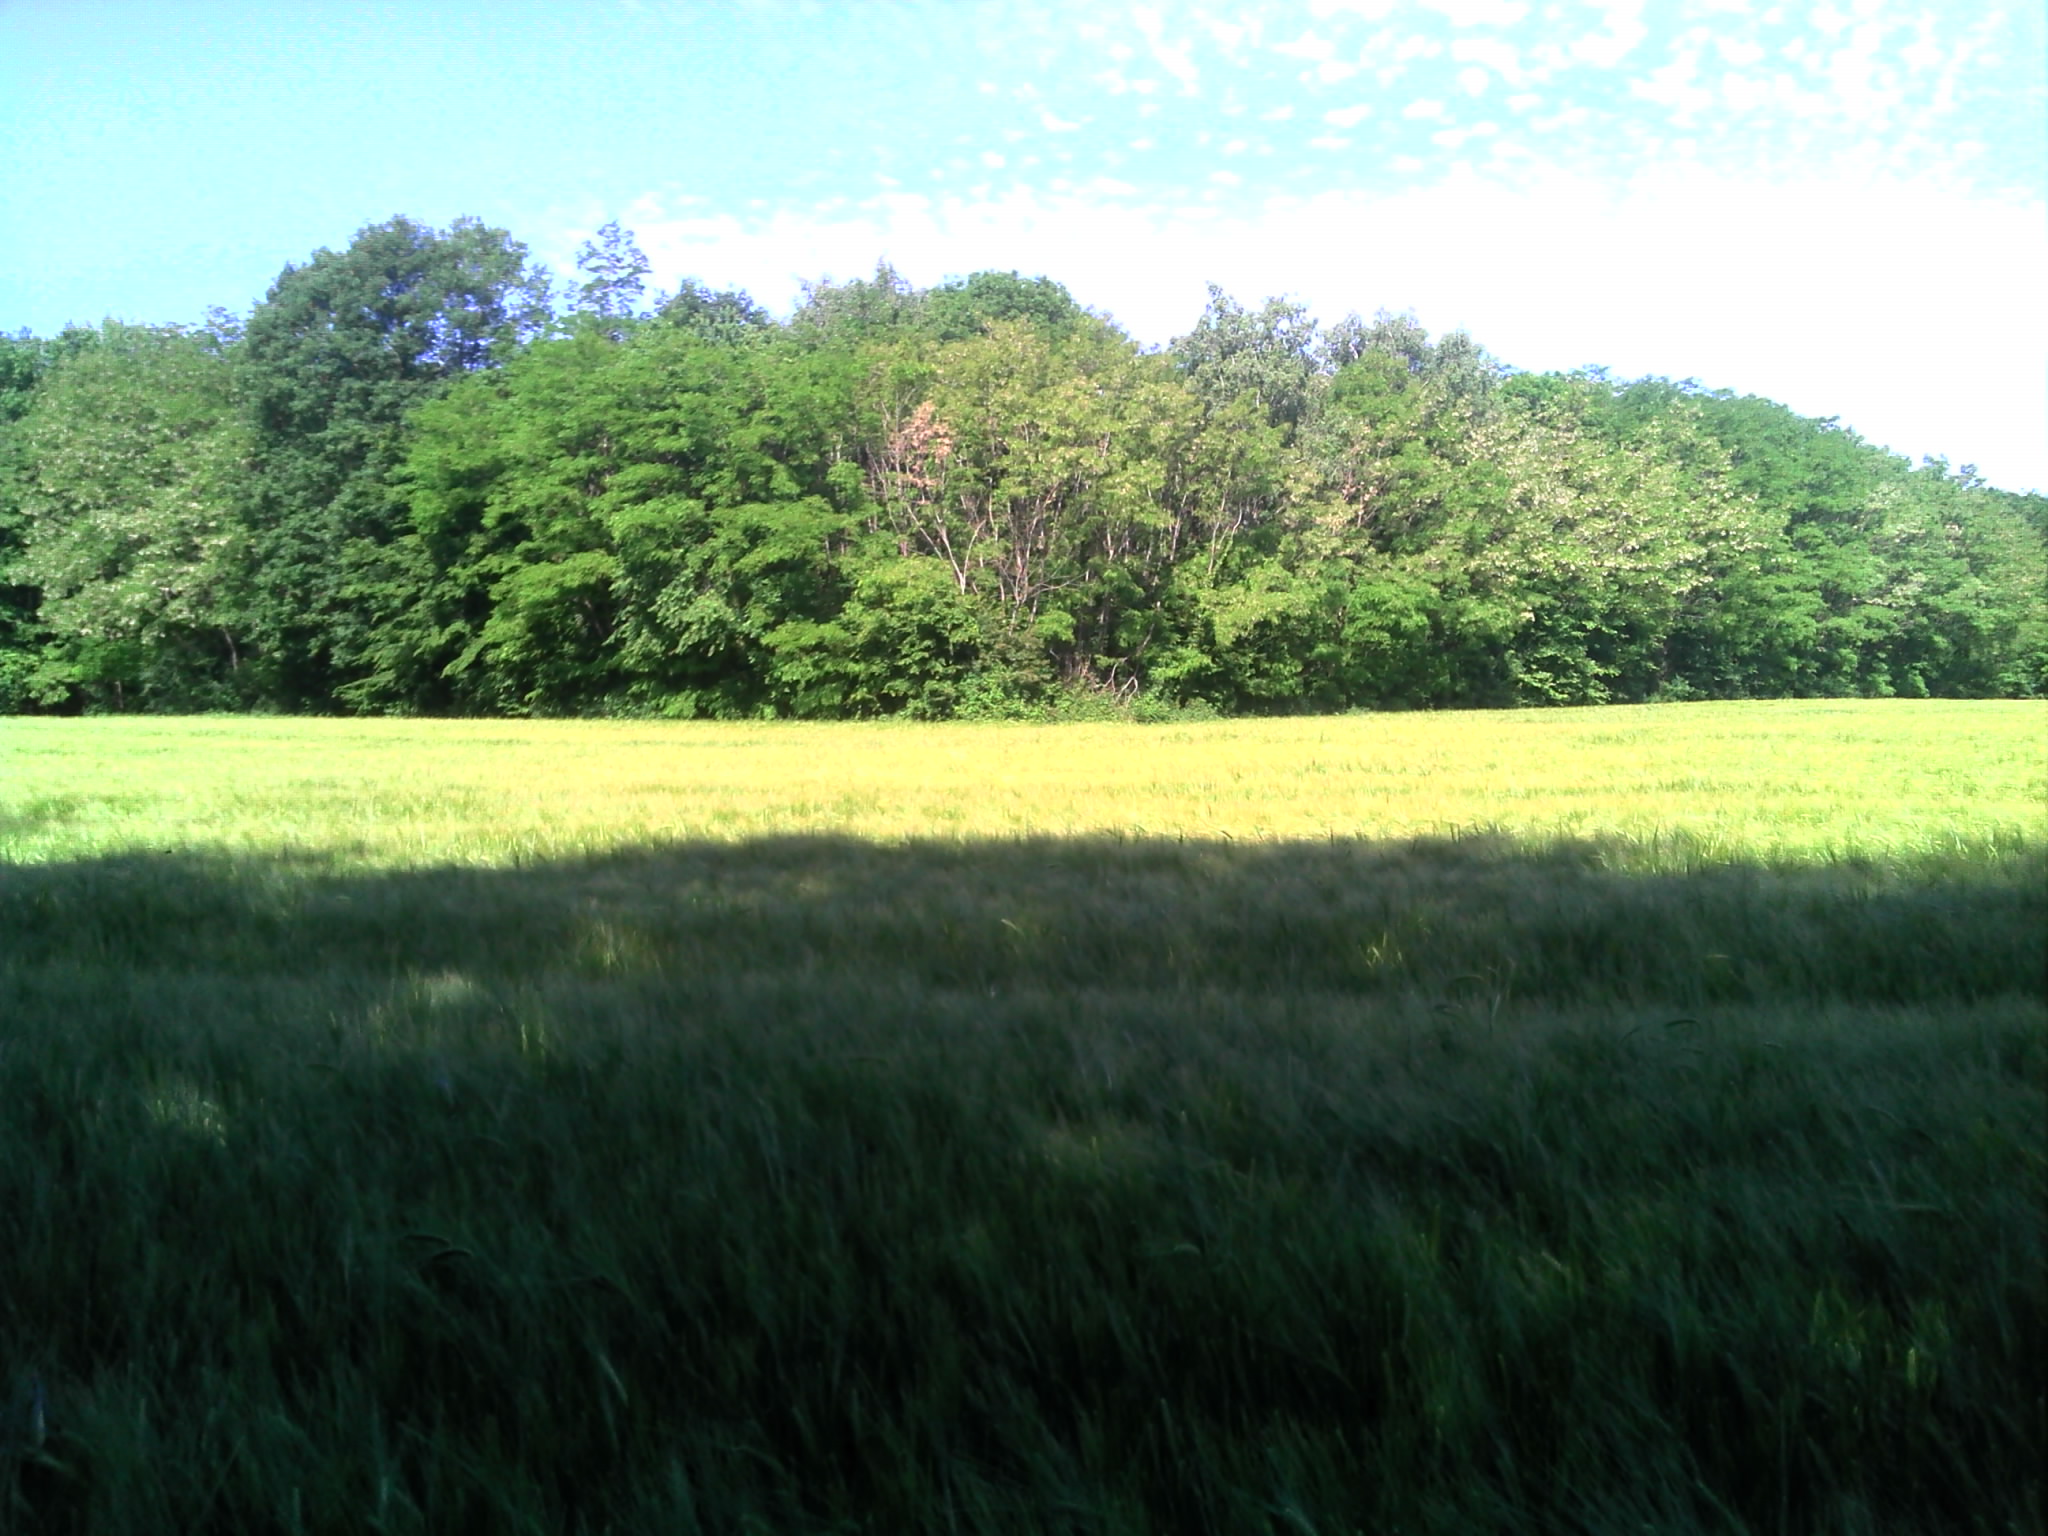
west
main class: Cropland
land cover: Barley
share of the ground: > 75 %
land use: Agriculture (excluding fallow land and kitchen gardens)
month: May
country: FR
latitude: 46.6157
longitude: 5.0530
